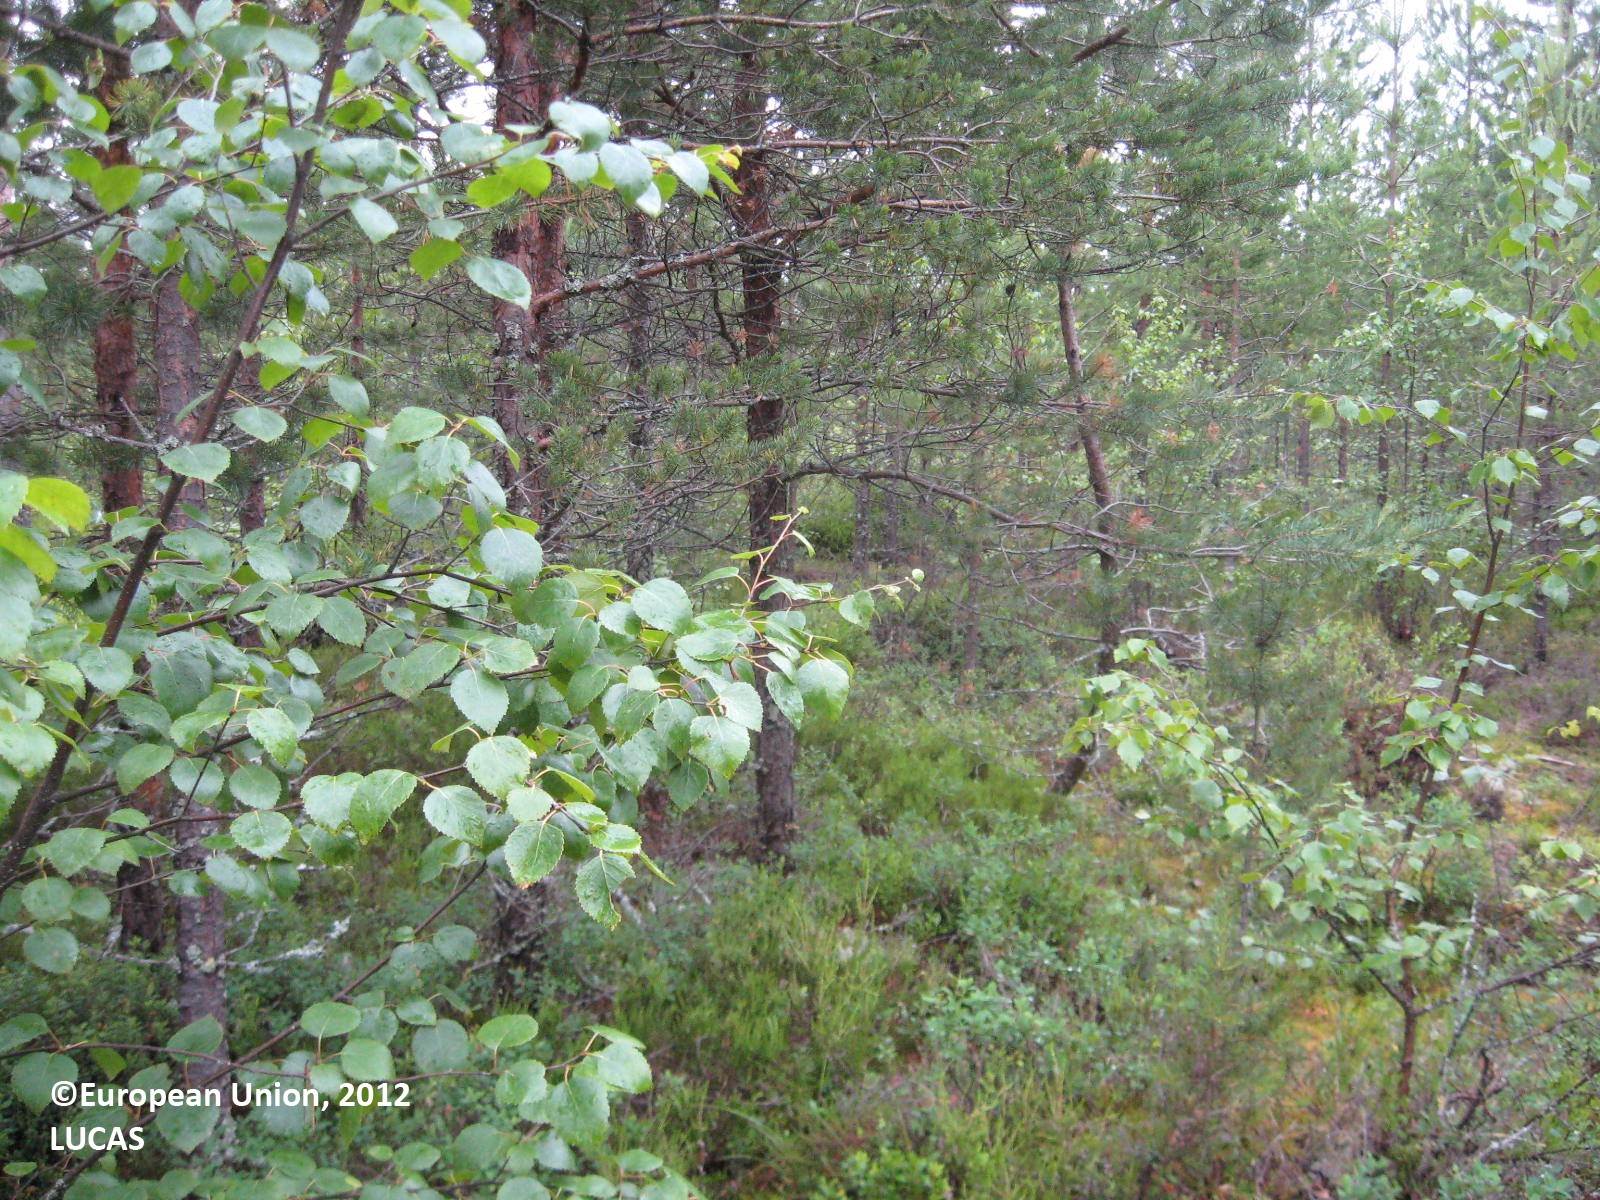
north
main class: Woodland
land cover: Pine dominated coniferous woodland
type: boreal forest
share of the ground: > 75 %
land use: Forestry
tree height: < 5 m
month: July
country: FI
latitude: 62.3763
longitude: 22.5658
